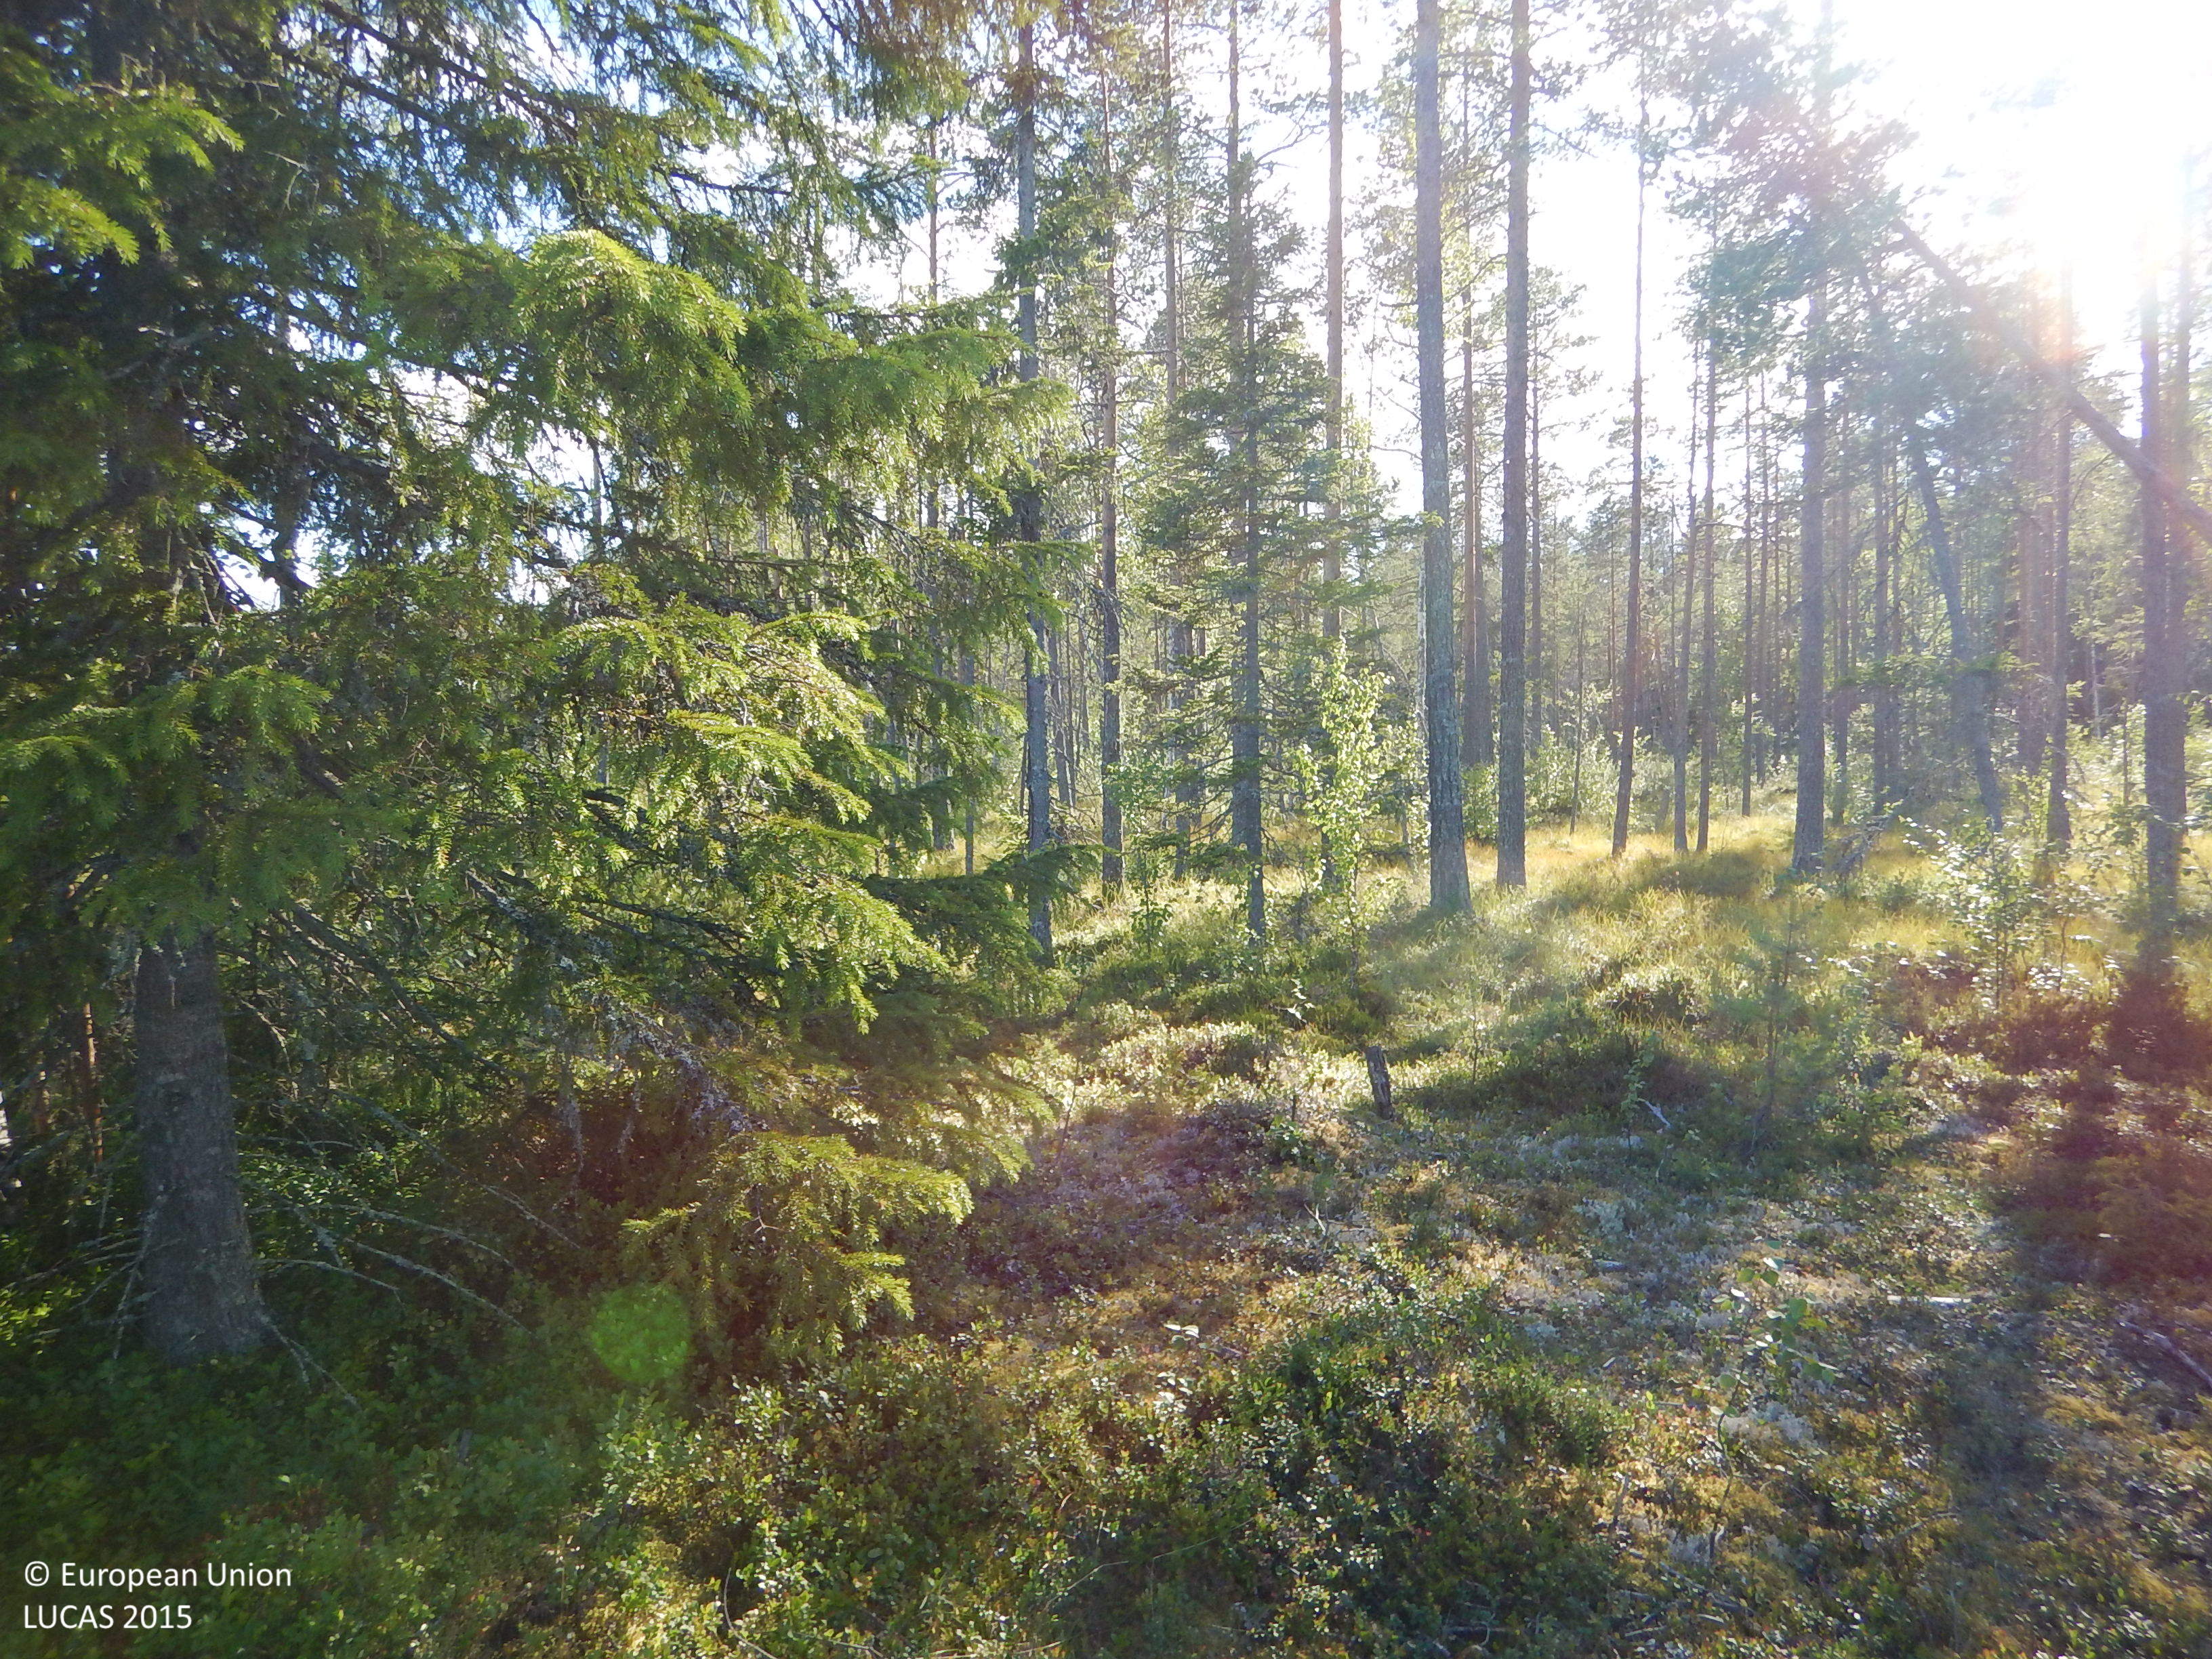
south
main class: Woodland
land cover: Pine dominated mixed woodland
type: boreal forest
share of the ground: 25 - 50 %
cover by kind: coniferous forest trees 25 %, shrubs 25 %, broadleaved forest trees 20 %, herbaceous plants 20 %, lichens and mosses 10 %
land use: Forestry
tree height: < 5 m
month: July
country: SE
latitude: 64.8071
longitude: 20.9046
